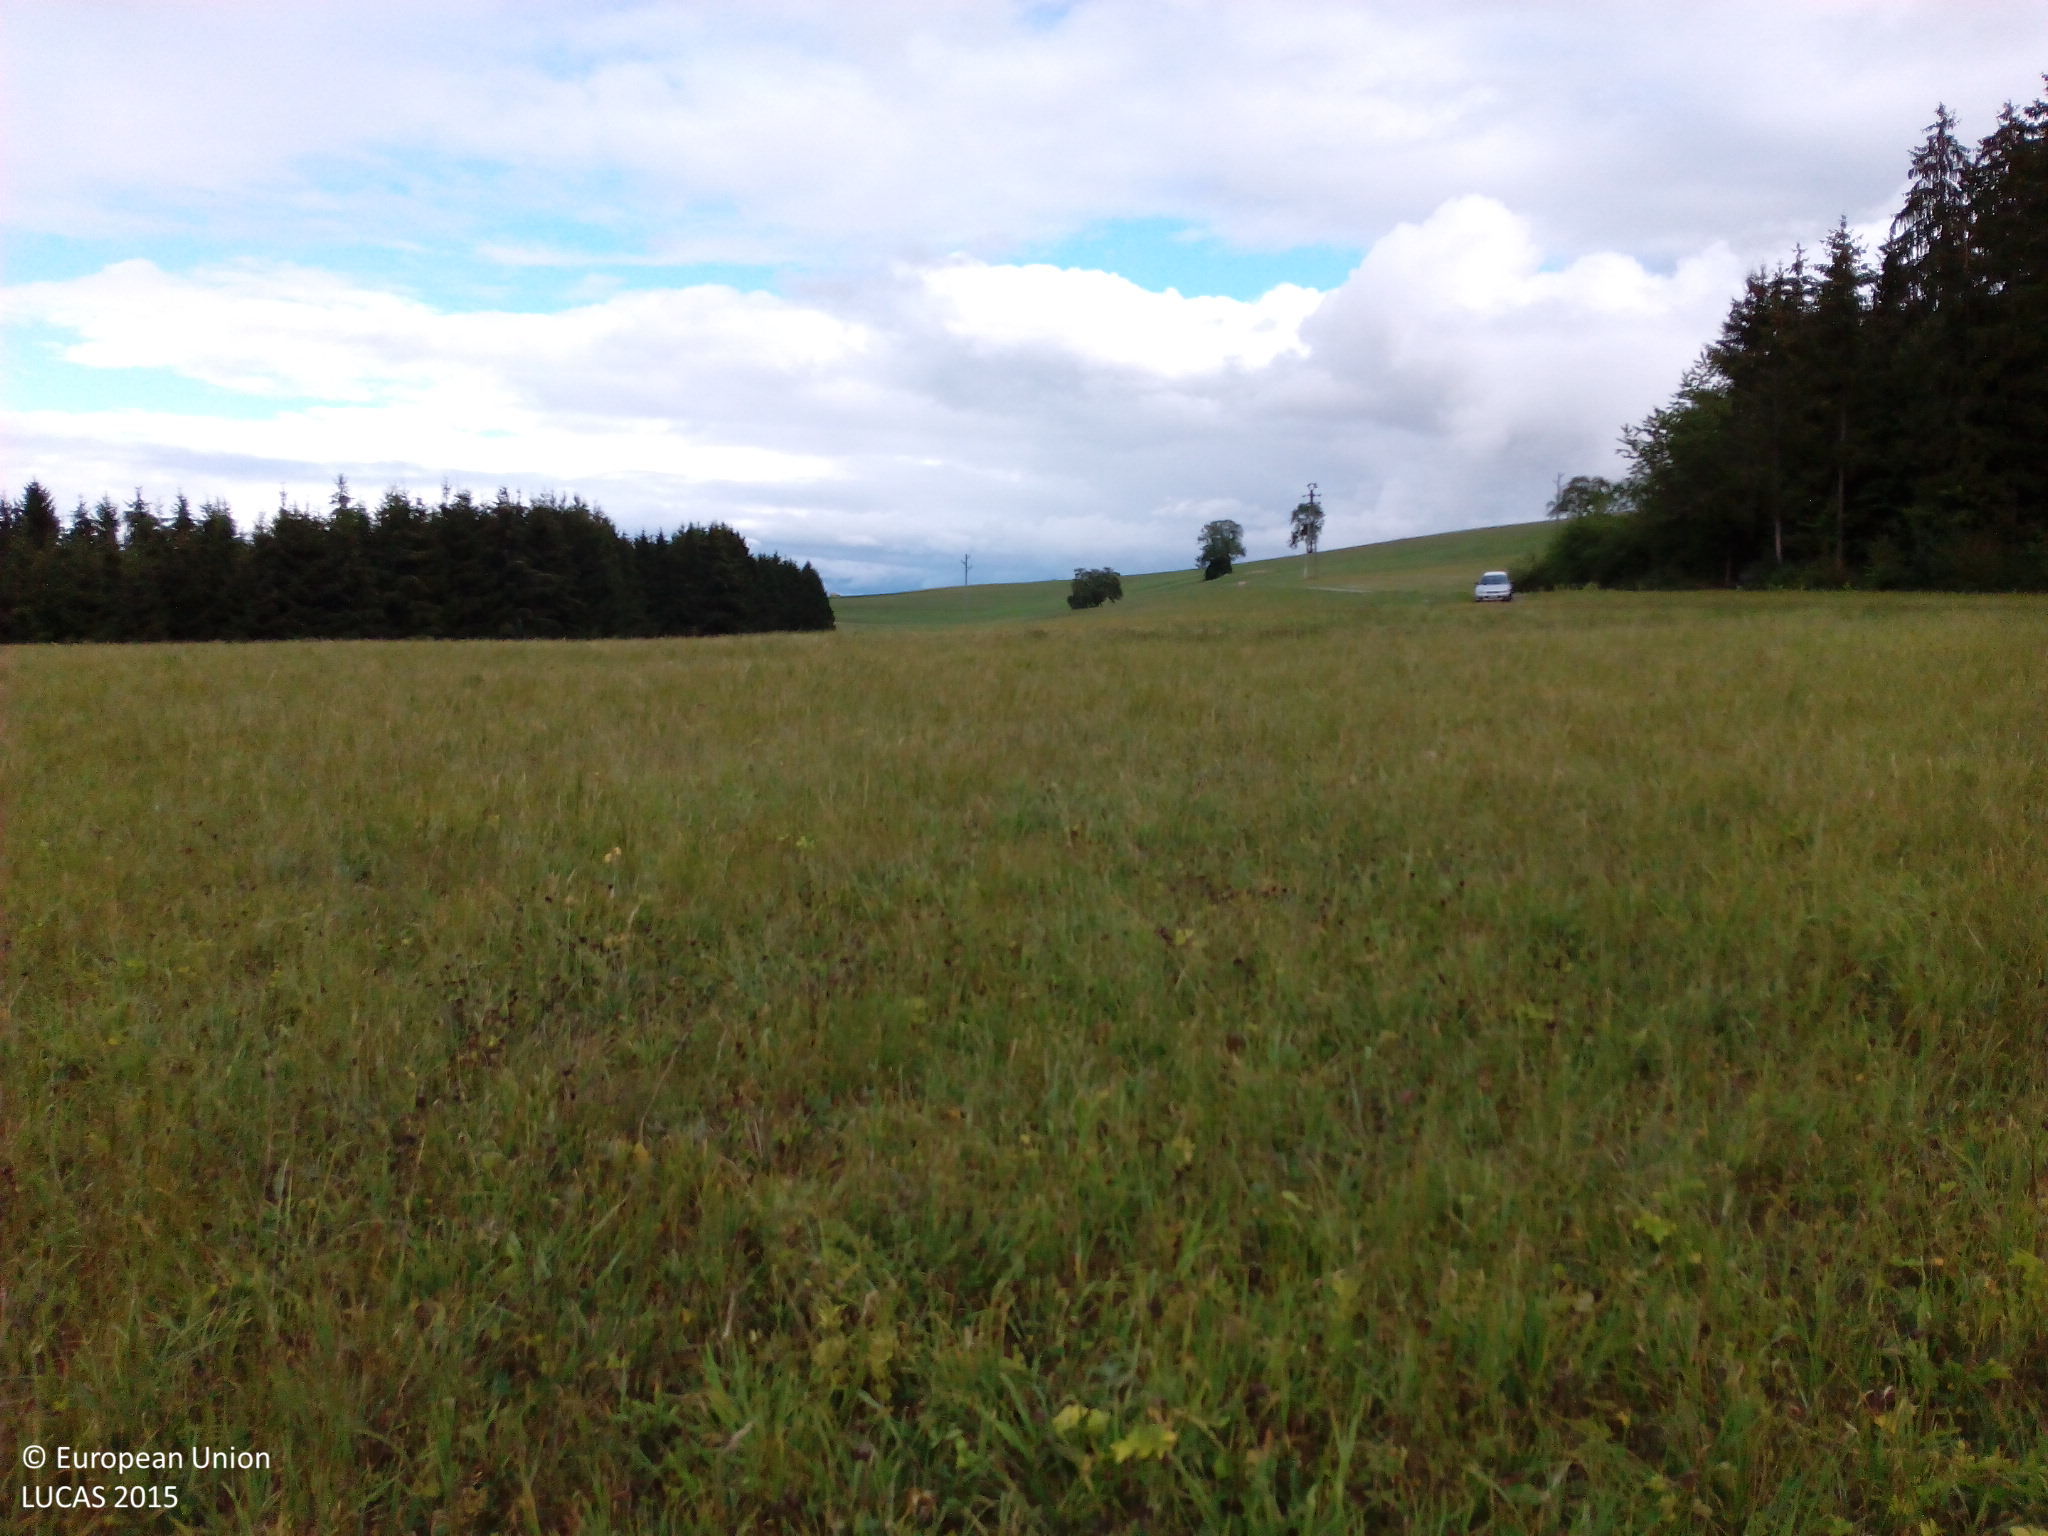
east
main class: Grassland
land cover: Grassland without tree/shrub cover
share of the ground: > 75 %
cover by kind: herbaceous plants 100 %
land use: Agriculture (excluding fallow land and kitchen gardens)
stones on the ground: < 10 %
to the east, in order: Grassland without tree/shrub cover; Tracks; Grassland without tree/shrub cover; Tracks; Grassland without tree/shrub cover; Electric lines; Grassland without tree/shrub cover
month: August
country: DE
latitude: 47.6869
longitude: 8.2027
